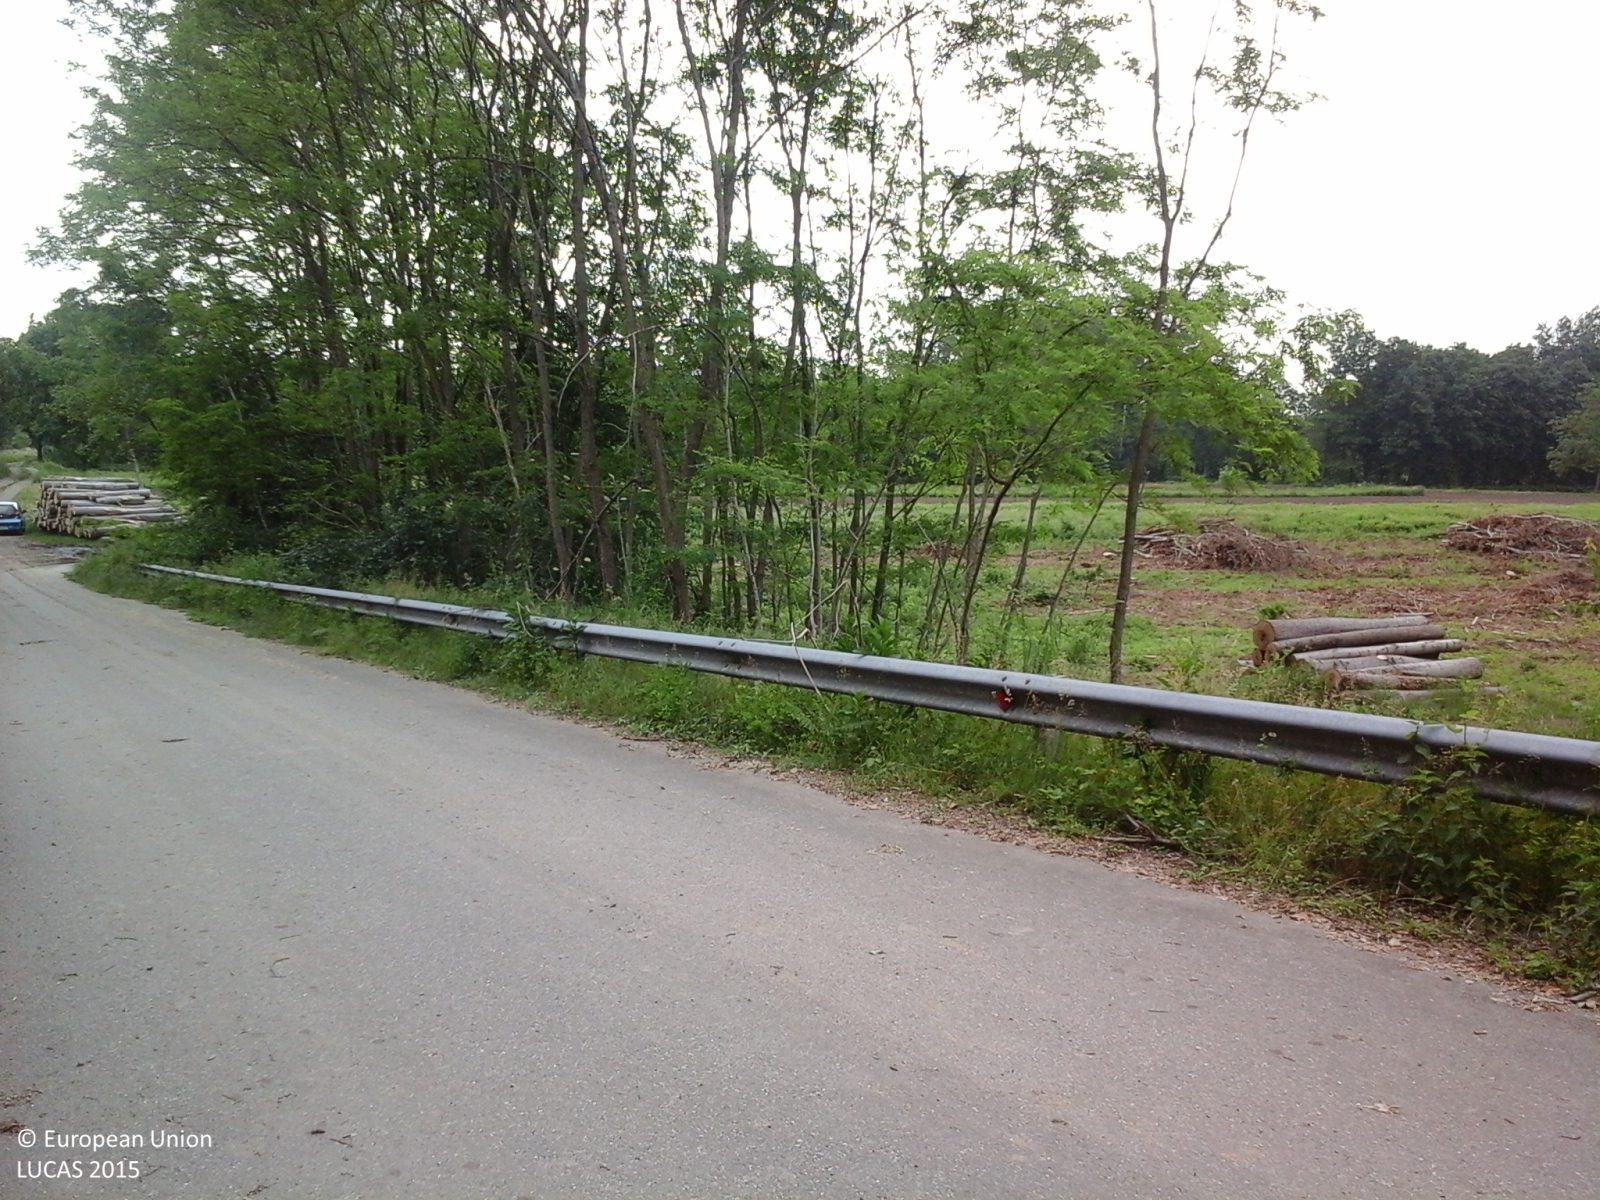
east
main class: Woodland
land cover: Broadleaved woodland
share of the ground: > 75 %
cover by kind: broadleaved forest trees 100 %
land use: Forestry
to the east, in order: Broadleaved woodland; Paved roads, cycling and walking lanes; Broadleaved woodland; Spontaneously vegetated surfaces; Other bare soil; Spontaneously vegetated surfaces; Other bare soil; Spontaneously vegetated surfaces; Tracks; Managed hedges; Other bare soil; Broadleaved woodland
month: May
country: IT
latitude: 45.5468
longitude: 8.4271
